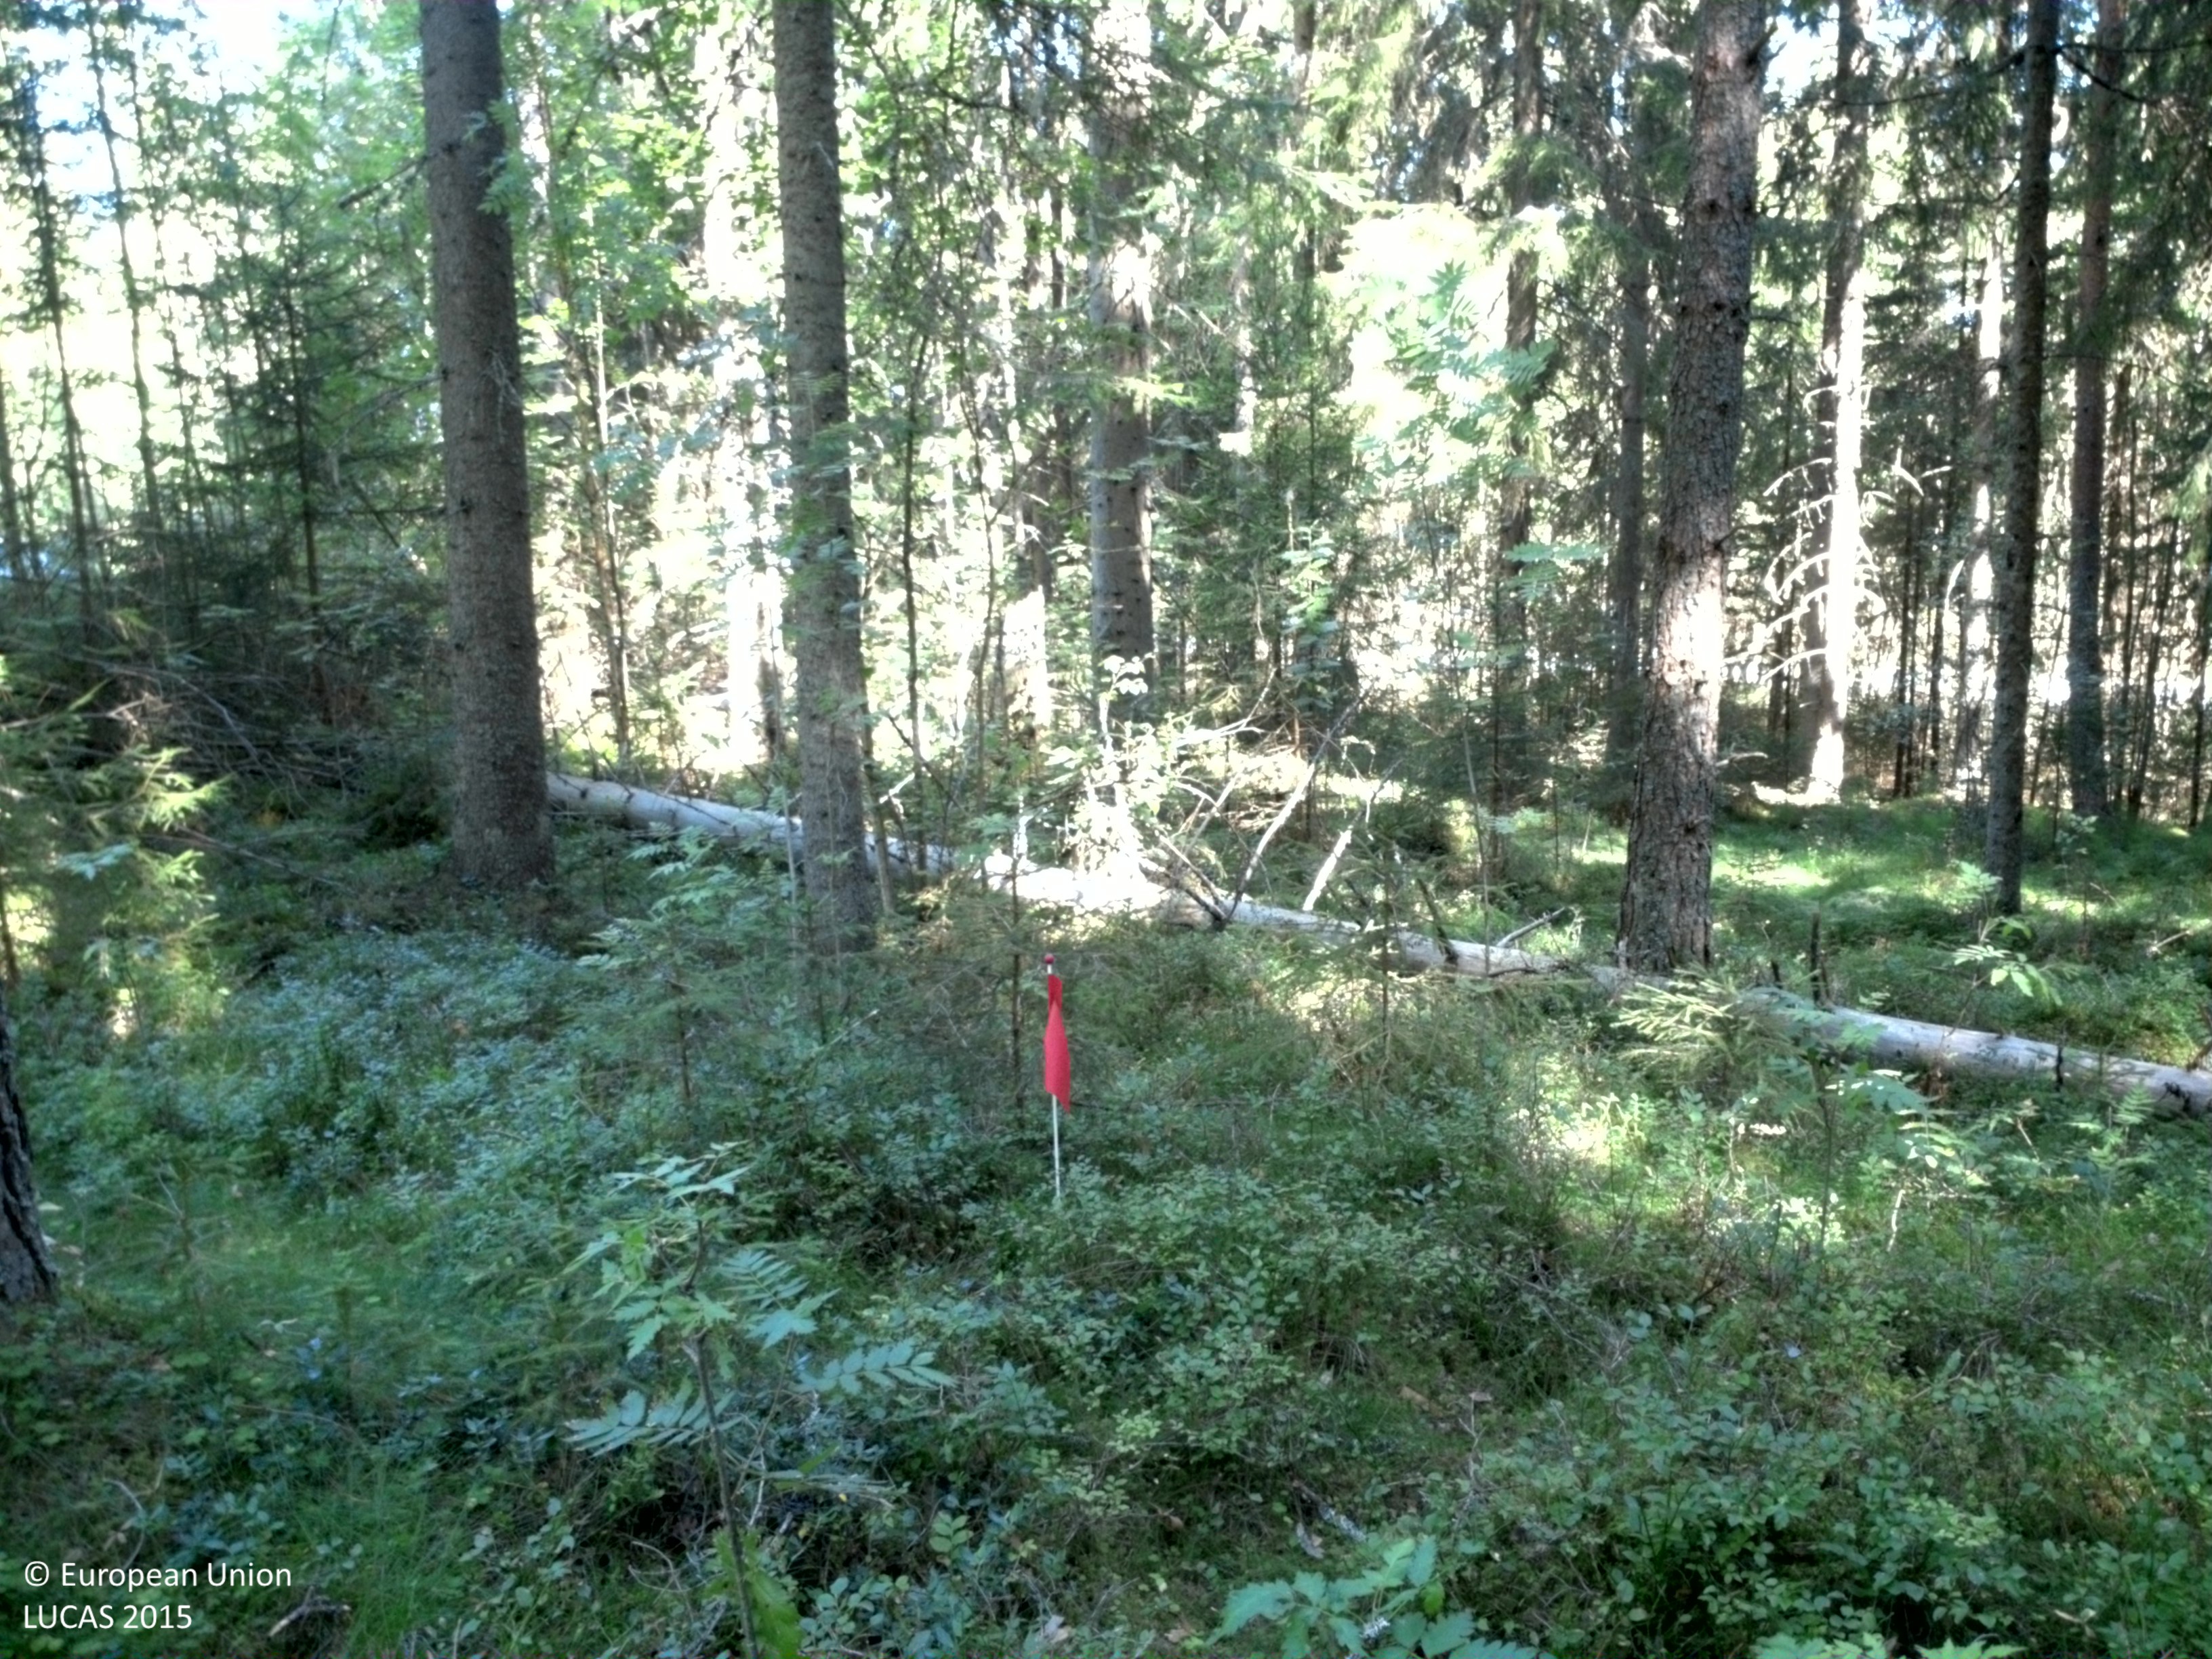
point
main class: Woodland
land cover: Spruce dominated coniferous woodland
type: boreal forest
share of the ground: 50 - 75 %
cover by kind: coniferous forest trees 65 %, lichens and mosses 20 %, broadleaved forest trees 5 %, shrubs 5 %, herbaceous plants 5 %
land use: Forestry
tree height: > 5 m
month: August
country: SE
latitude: 60.1183
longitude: 13.5354
